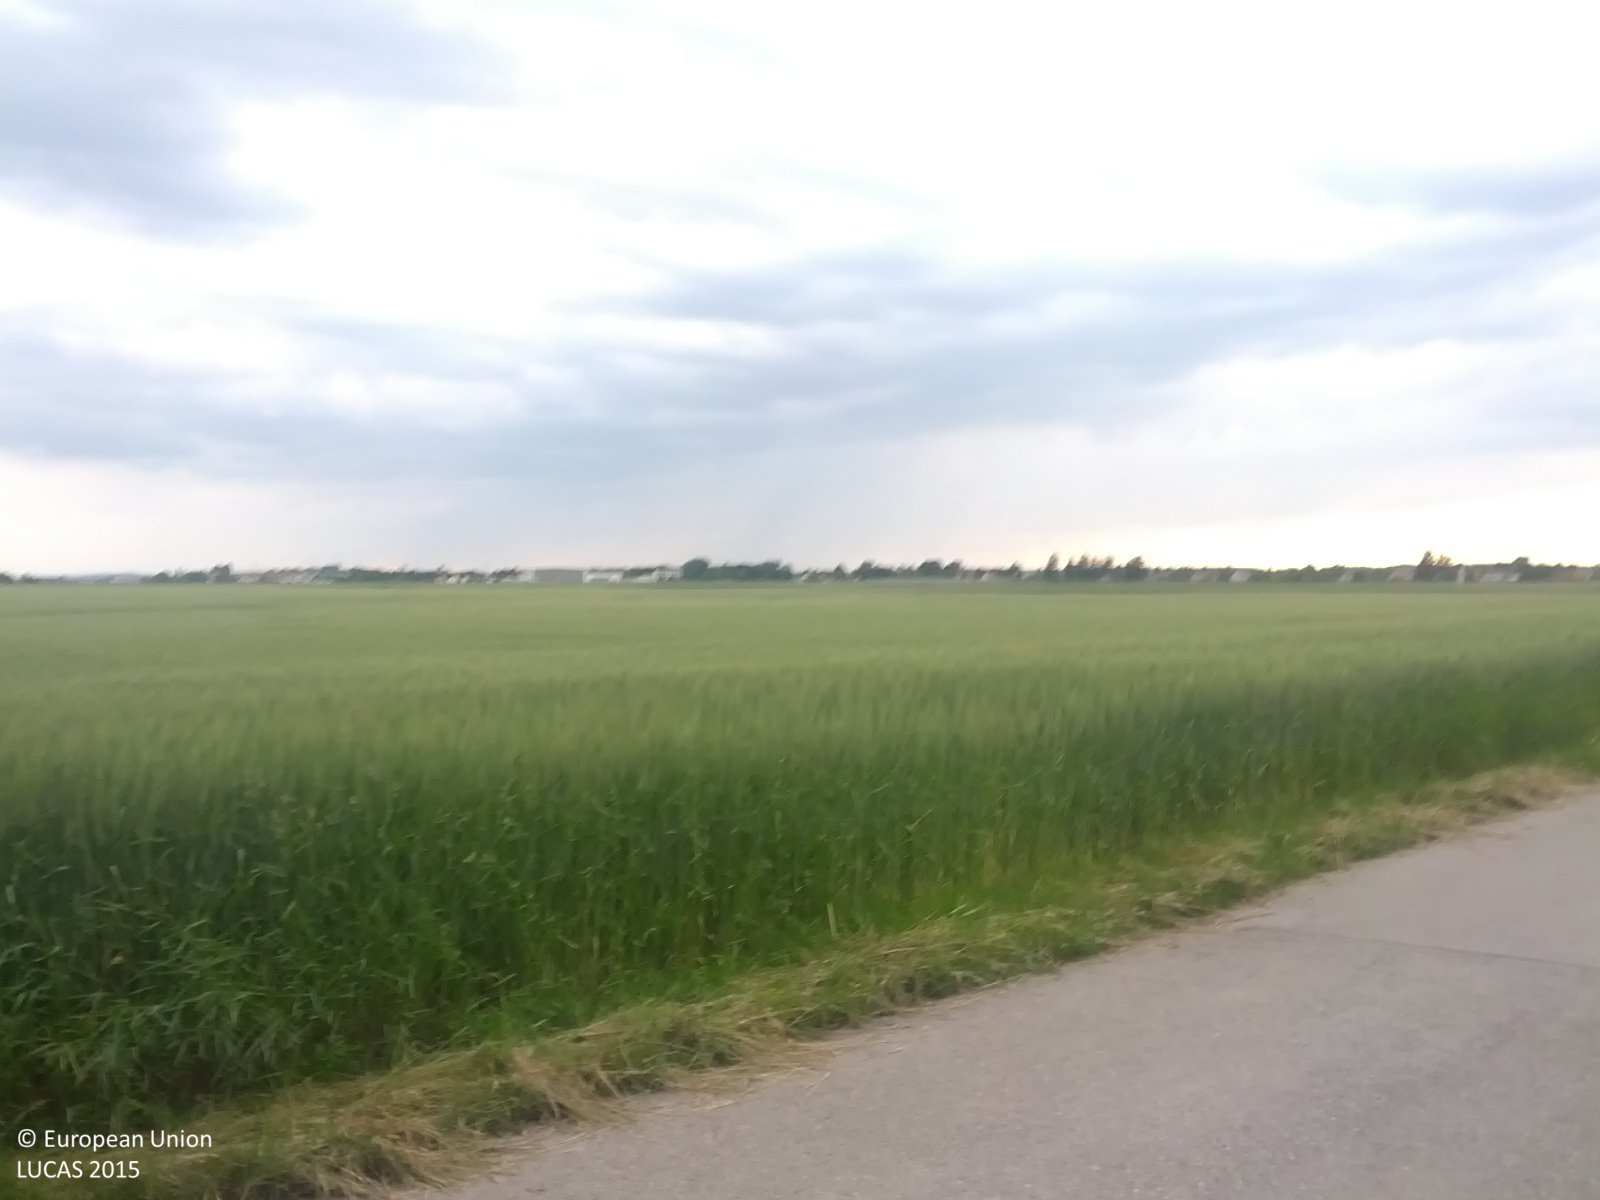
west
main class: Grassland
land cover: Grassland with sparse tree/shrub cover
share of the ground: > 75 %
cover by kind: herbaceous plants 90 %, coniferous forest trees 5 %, shrubs 5 %
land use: Residential
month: May
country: AT
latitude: 48.3230
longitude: 16.1409
